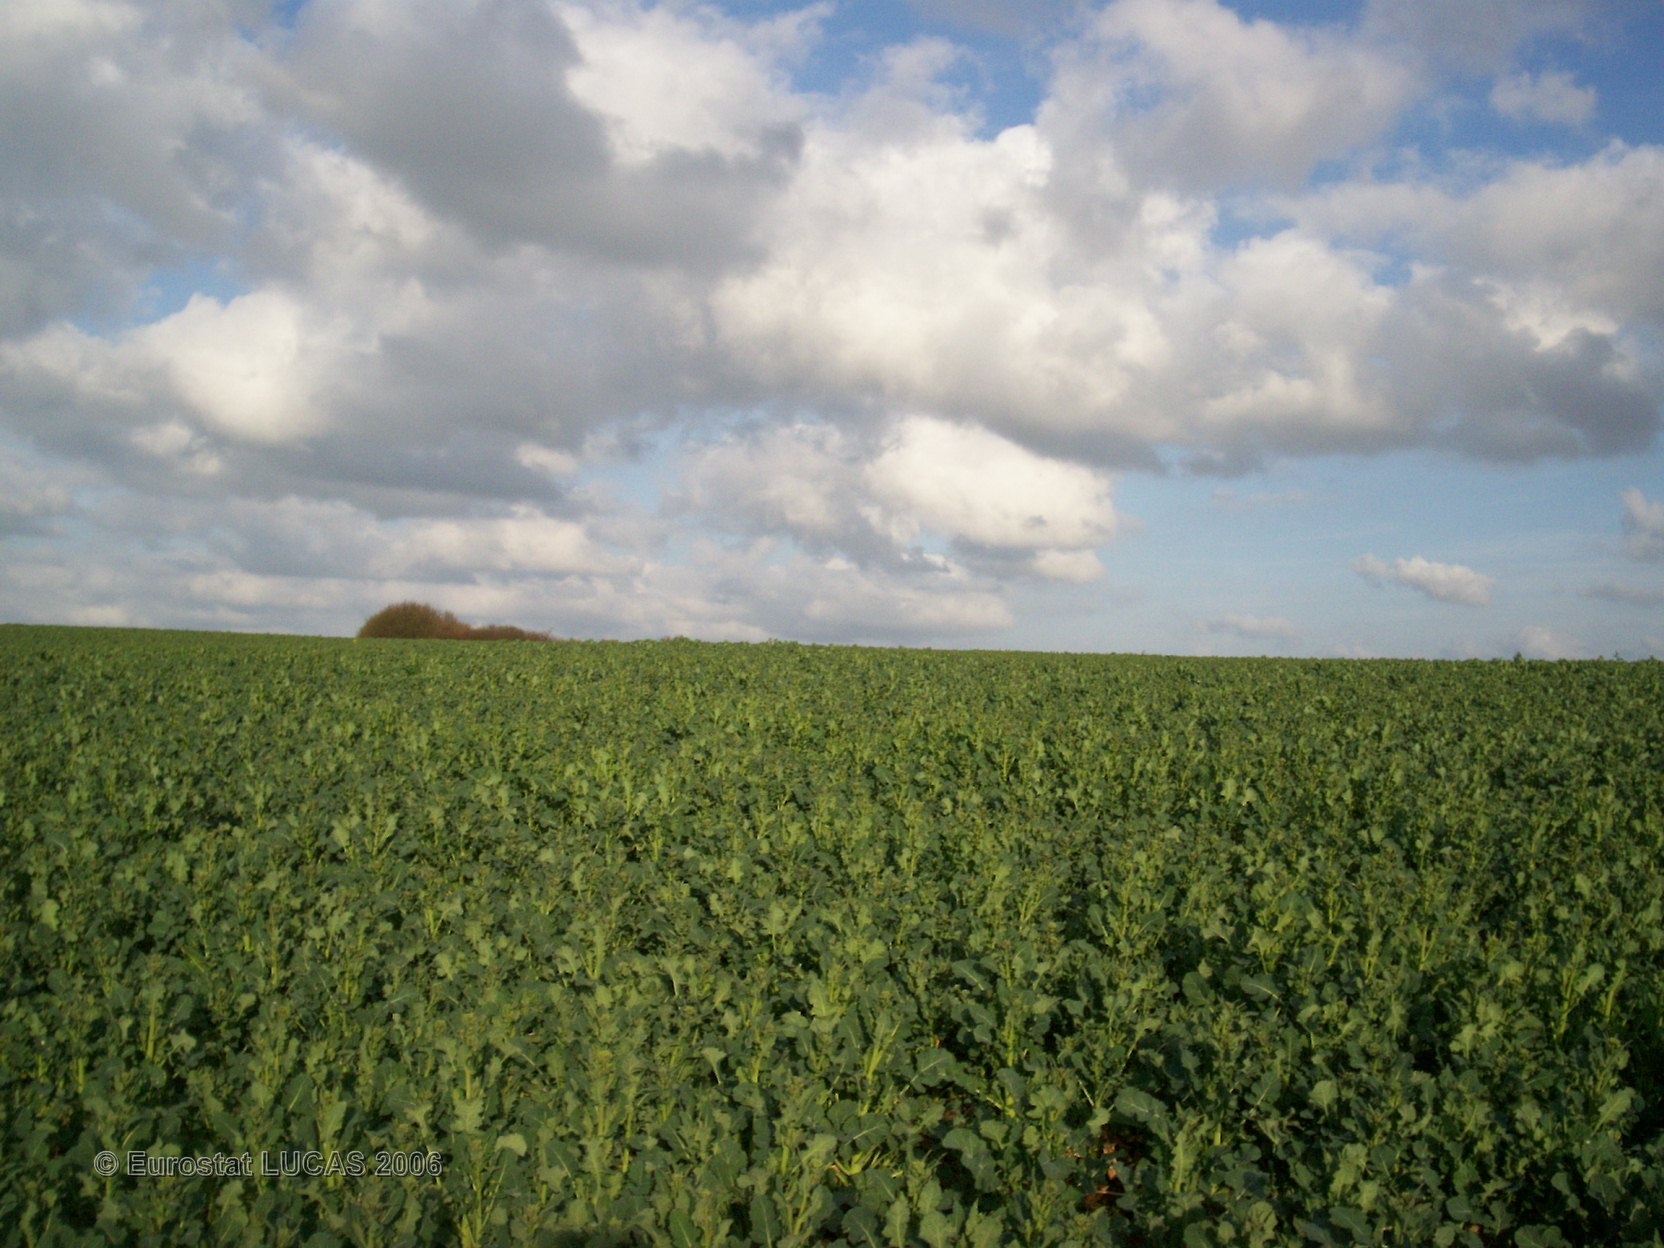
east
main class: Cropland
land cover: Rape and turnip rape
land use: Agriculture (excluding fallow land and kitchen gardens)
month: April
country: FR
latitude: 49.6949
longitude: 0.9241
